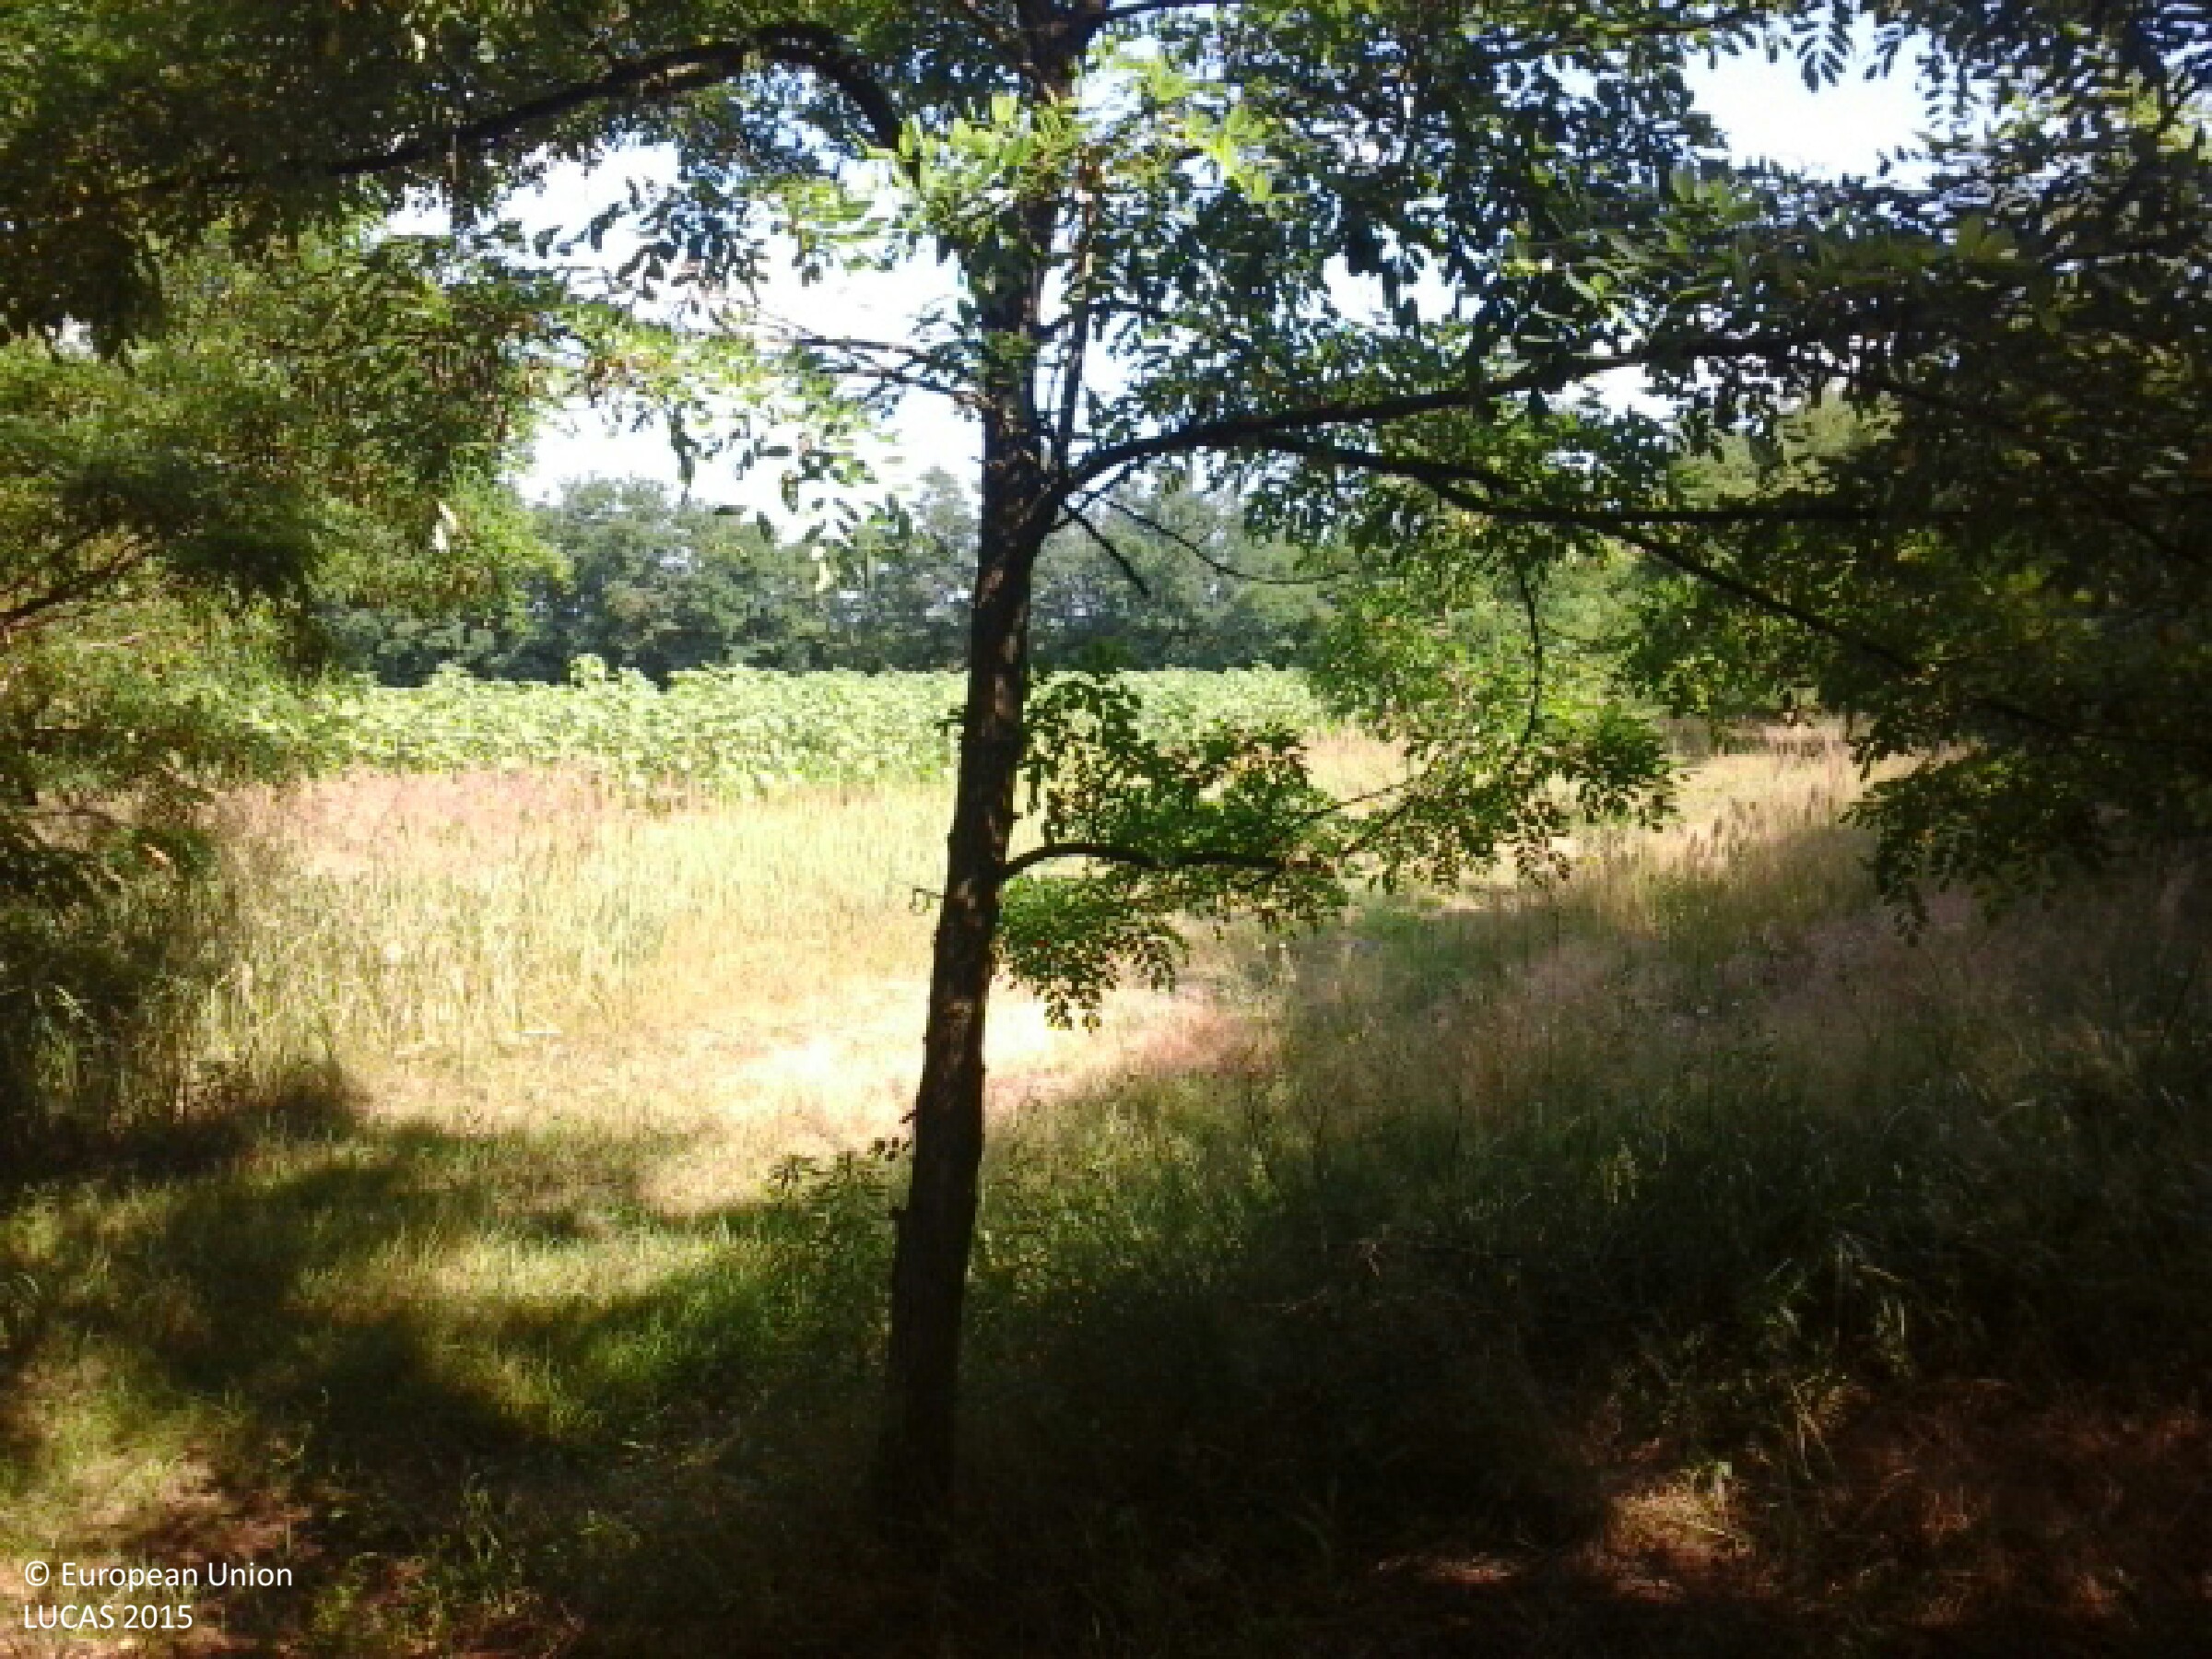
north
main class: Woodland
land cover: Broadleaved woodland
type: mesophytic deciduous forest
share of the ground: > 75 %
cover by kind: broadleaved forest trees 95 %, herbaceous plants 5 %
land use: Forestry
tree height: > 5 m
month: July
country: HU
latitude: 47.9554
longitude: 22.2548
